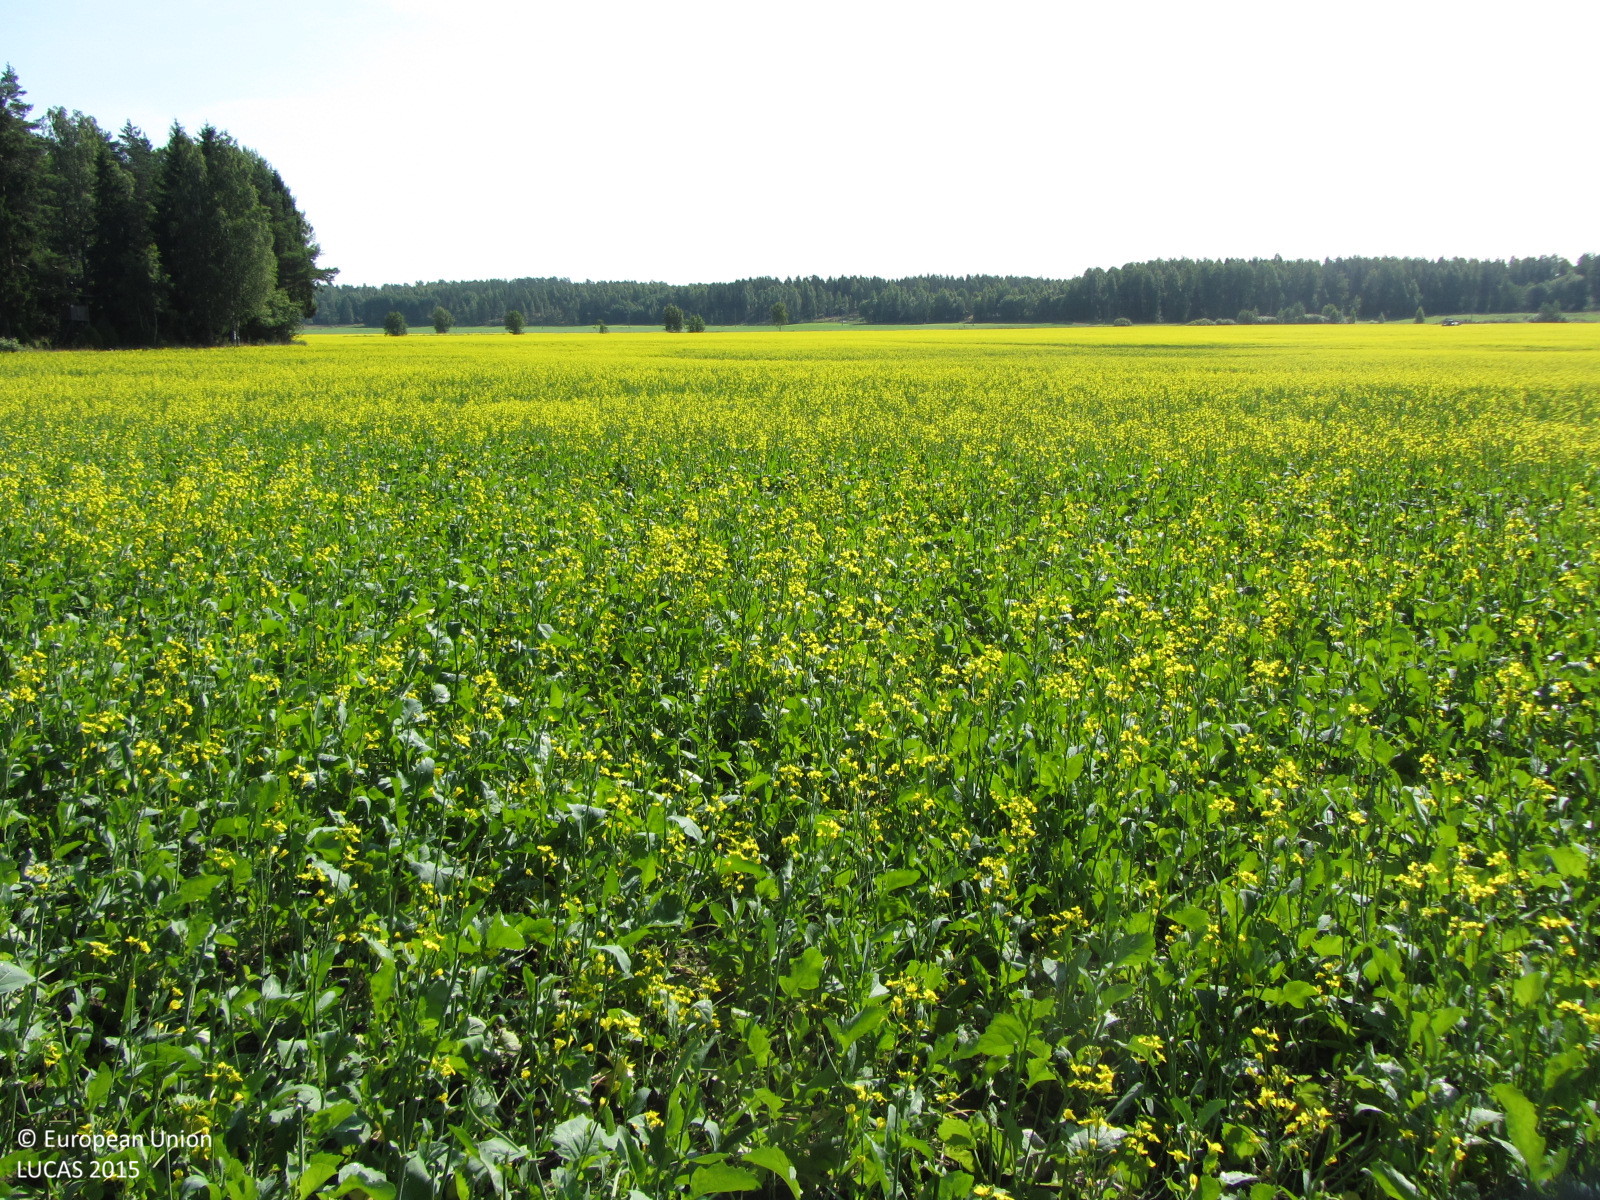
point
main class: Cropland
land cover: Rape and turnip rape
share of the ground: > 75 %
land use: Agriculture (excluding fallow land and kitchen gardens)
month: July
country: FI
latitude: 60.1168
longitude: 24.5592
